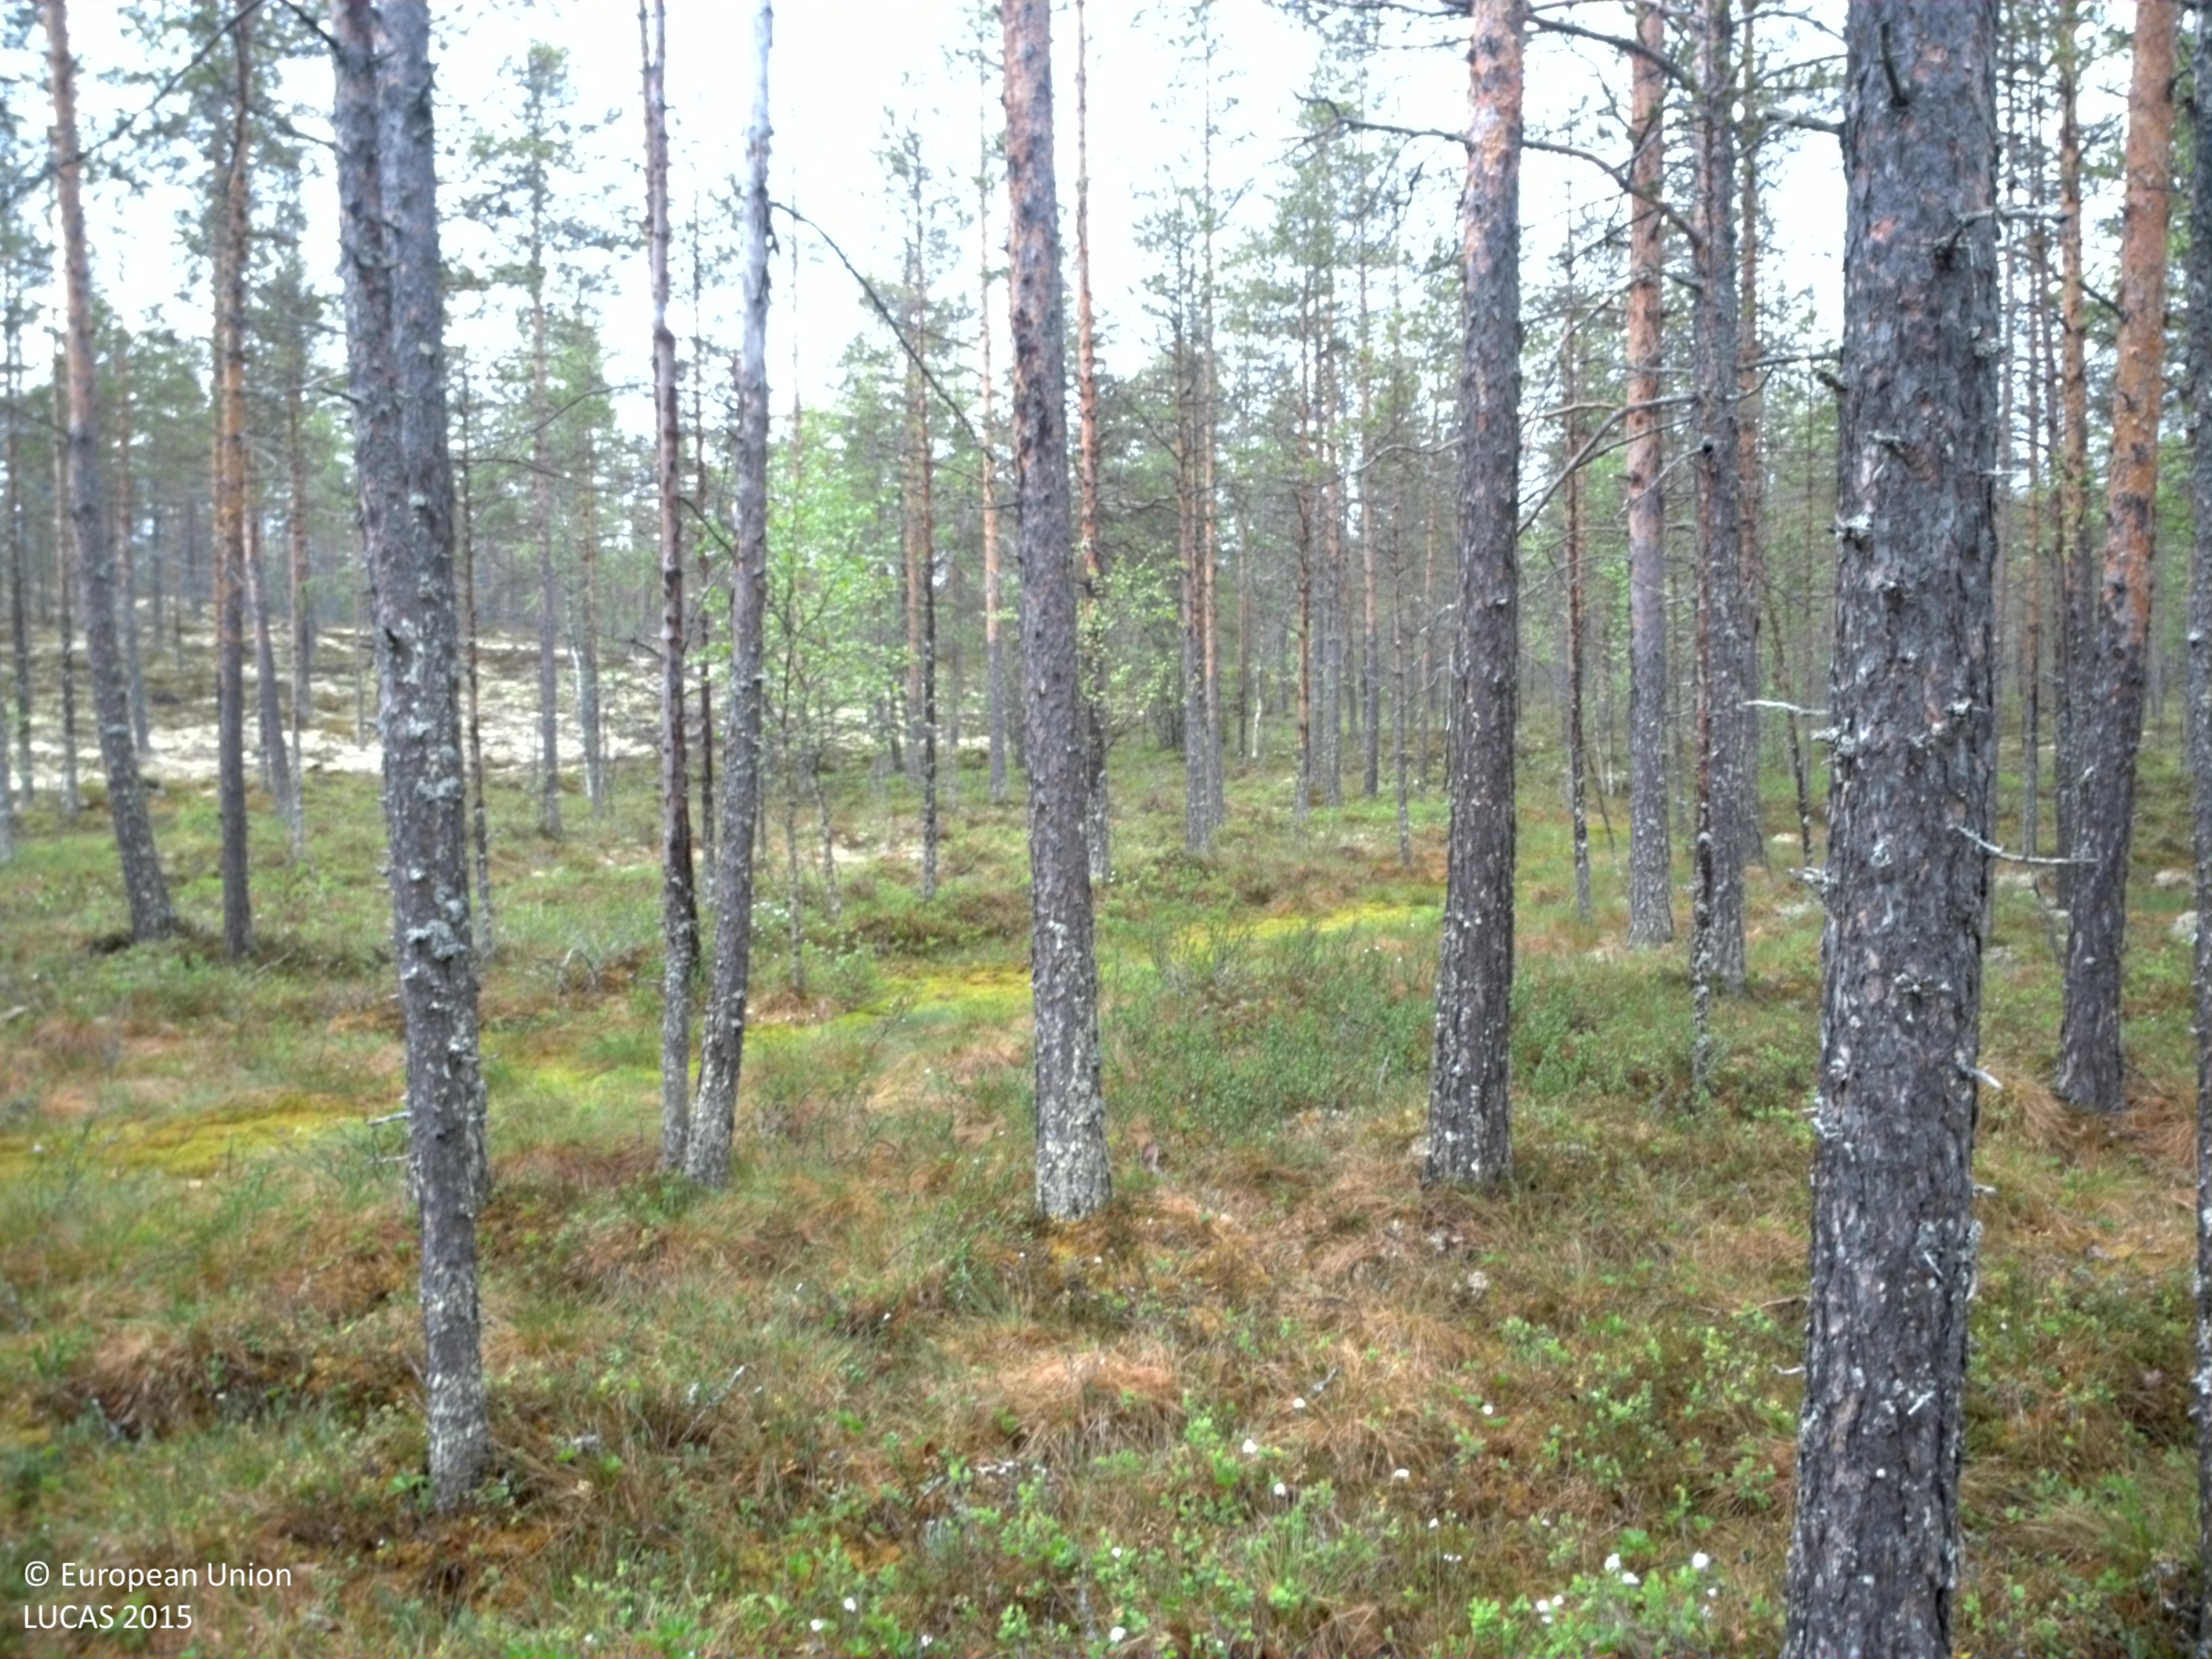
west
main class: Woodland
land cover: Pine dominated coniferous woodland
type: boreal forest
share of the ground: 50 - 75 %
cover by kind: coniferous forest trees 60 %, broadleaved forest trees 15 %, herbaceous plants 15 %, shrubs 10 %
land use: Forestry
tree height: > 5 m
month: June
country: SE
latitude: 61.5278
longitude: 13.3910
